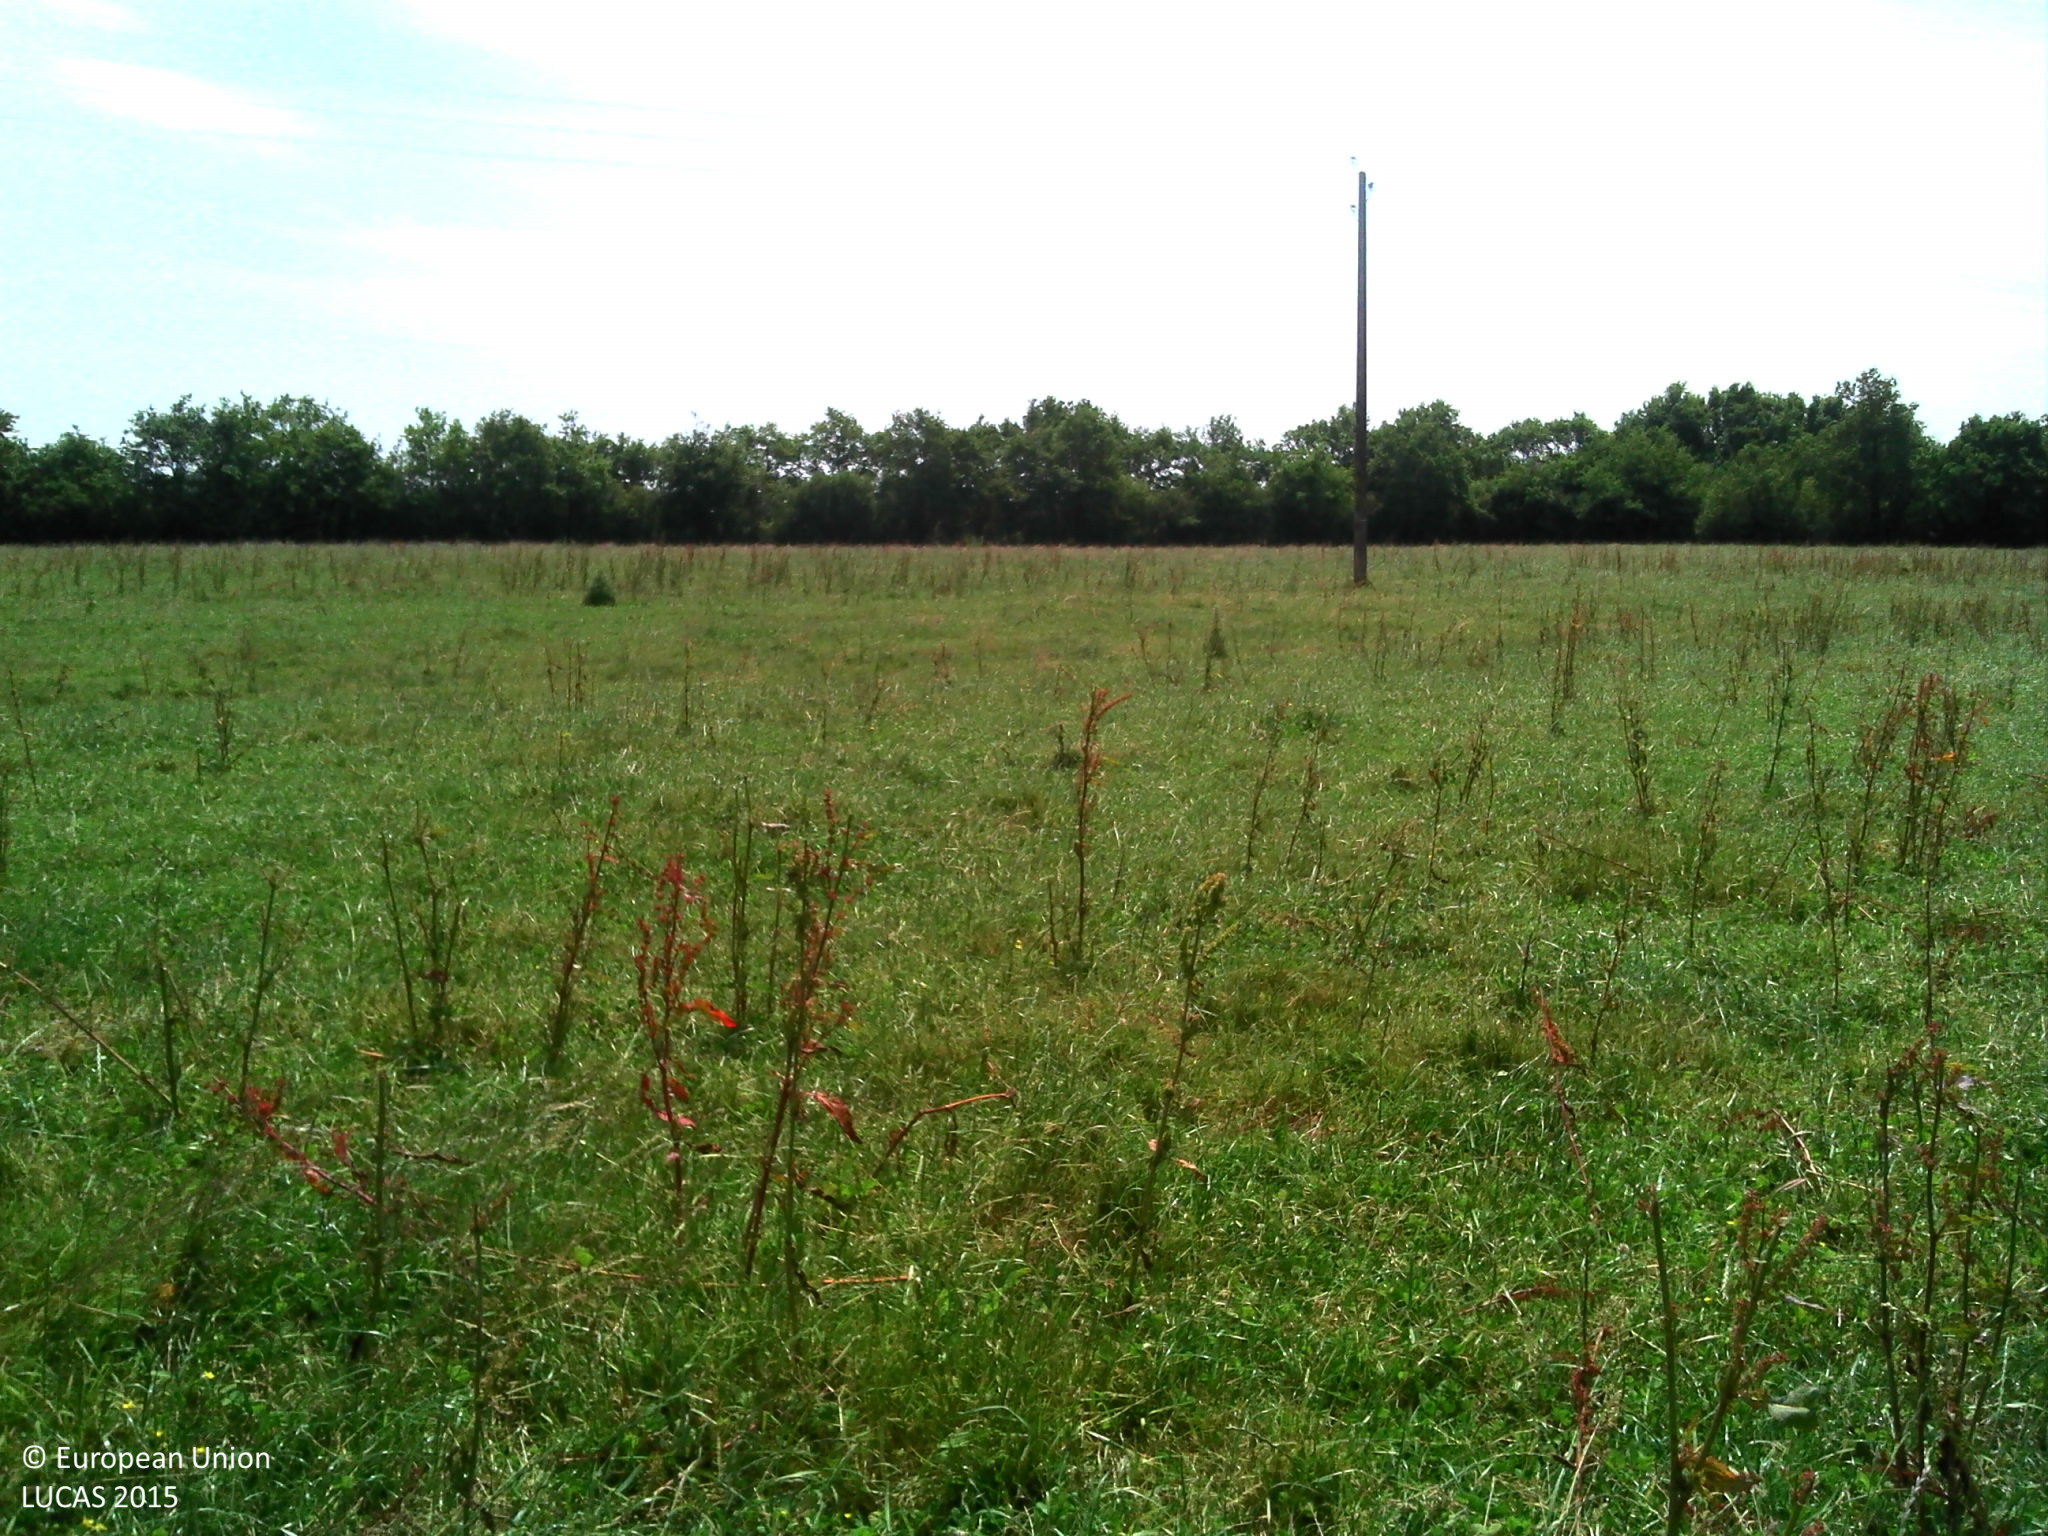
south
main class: Grassland
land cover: Grassland without tree/shrub cover
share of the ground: > 75 %
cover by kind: herbaceous plants 100 %
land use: Agriculture (excluding fallow land and kitchen gardens)
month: June
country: FR
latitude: 46.8169
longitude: -1.6936
